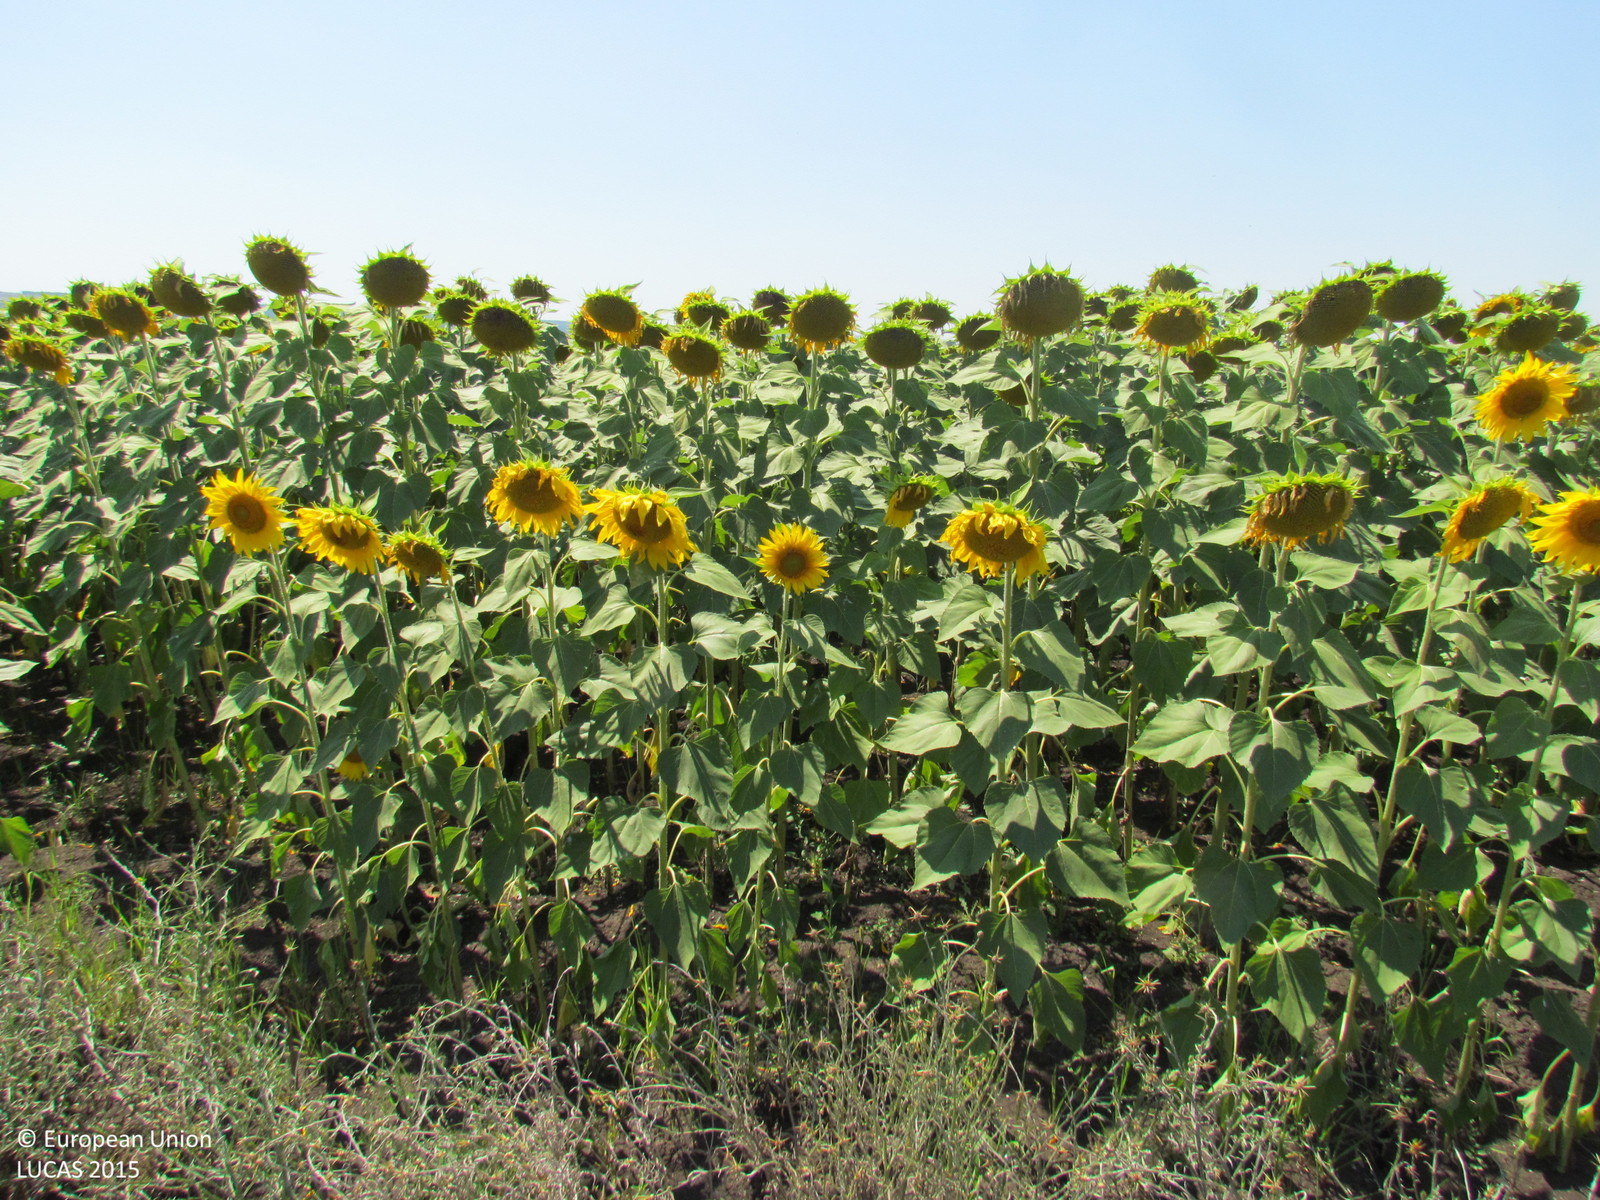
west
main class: Cropland
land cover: Sunflower
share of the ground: > 75 %
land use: Agriculture (excluding fallow land and kitchen gardens)
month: July
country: BG
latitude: 42.4260
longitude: 27.2849
